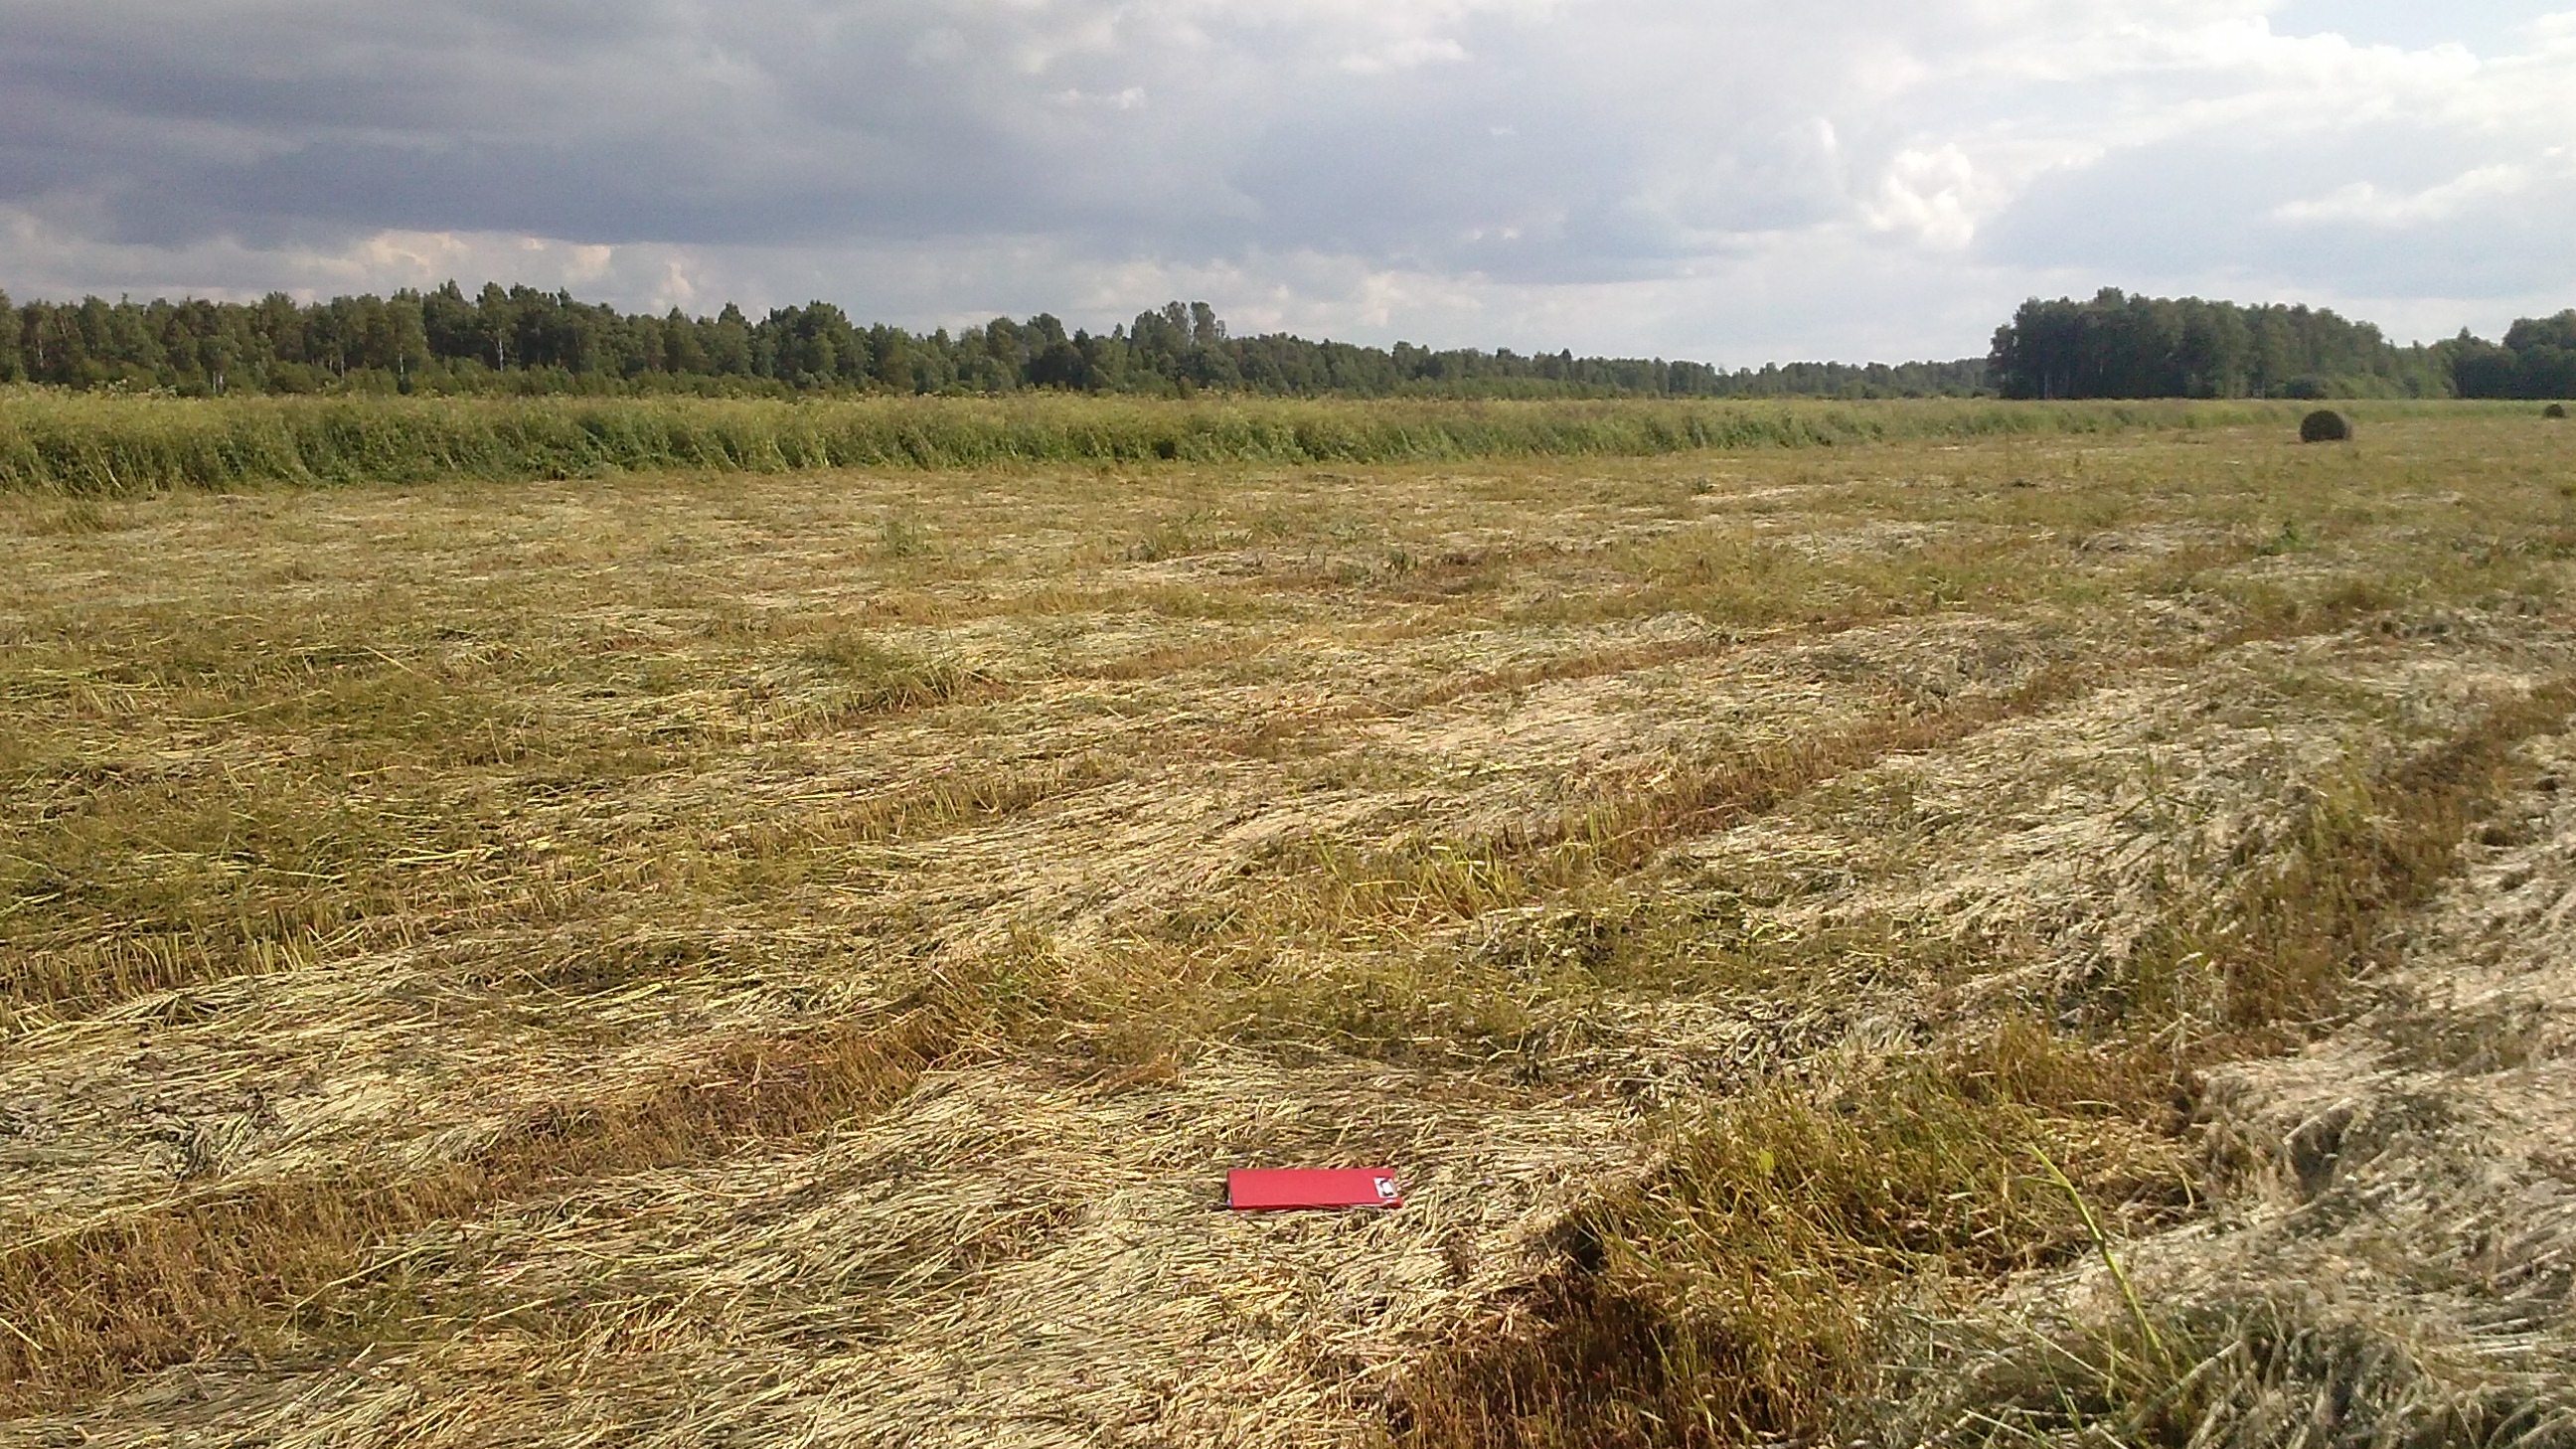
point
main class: Grassland
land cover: Grassland without tree/shrub cover
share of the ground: > 75 %
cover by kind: herbaceous plants 100 %
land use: Agriculture (excluding fallow land and kitchen gardens)
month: June
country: LV
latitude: 56.6562
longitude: 27.8571
